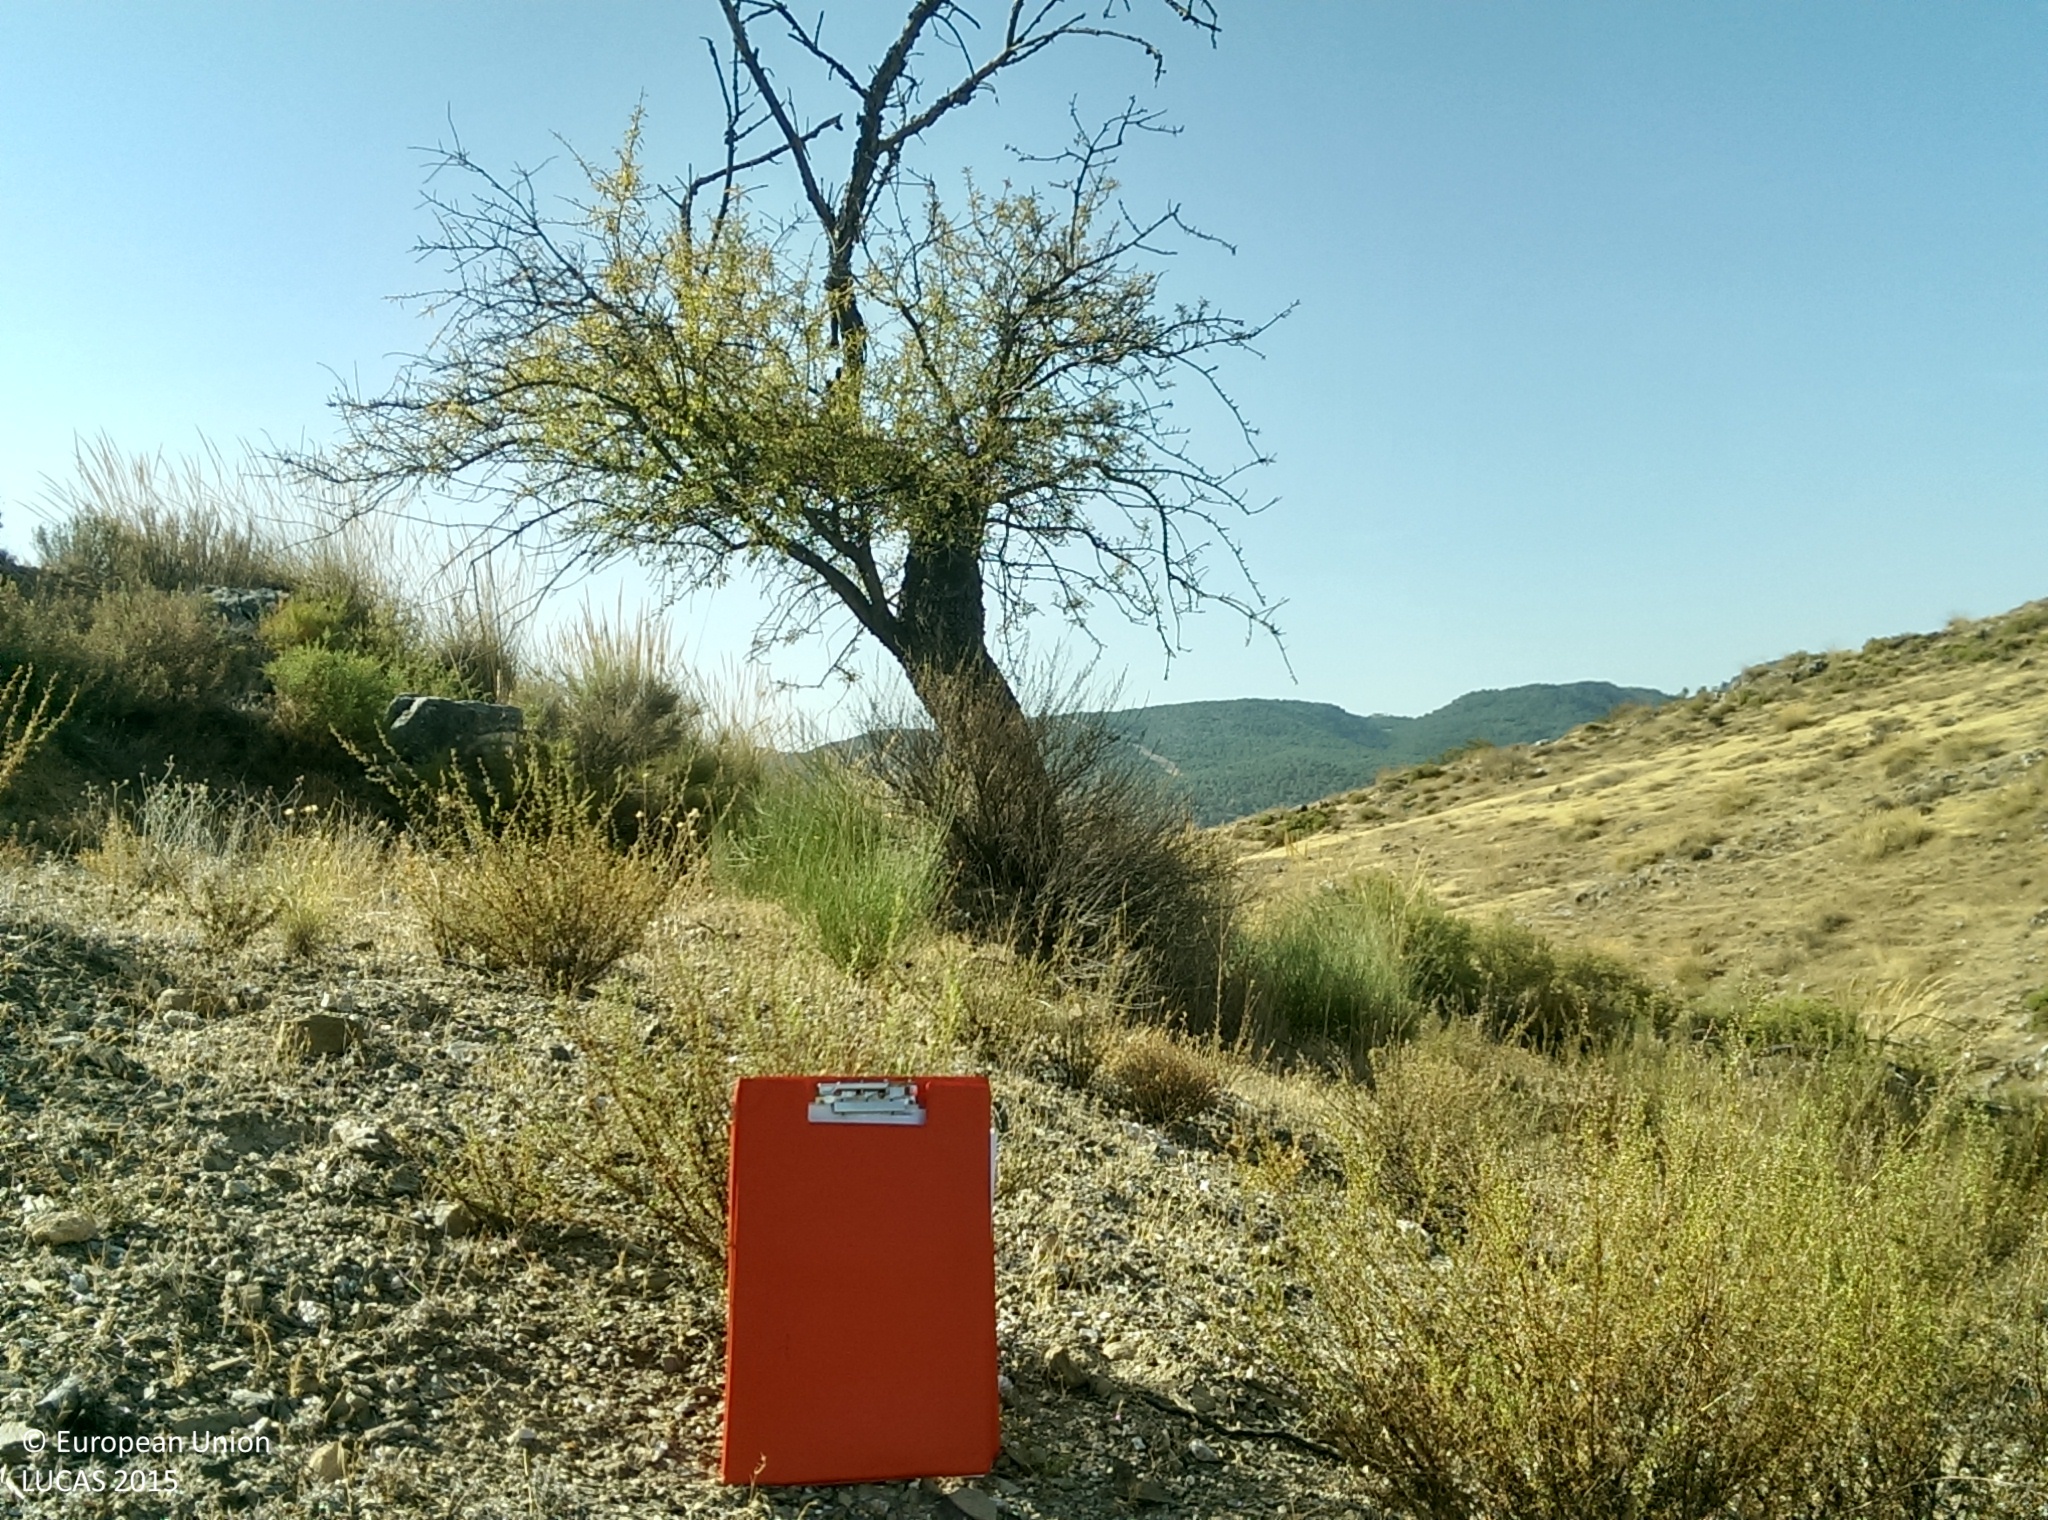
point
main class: Cropland
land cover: Nuts trees
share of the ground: 10 - 25 %
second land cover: Spontaneously vegetated surfaces
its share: 50 - 75 %
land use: Agriculture (excluding fallow land and kitchen gardens)
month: August
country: ES
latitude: 36.9418
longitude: -3.6509
